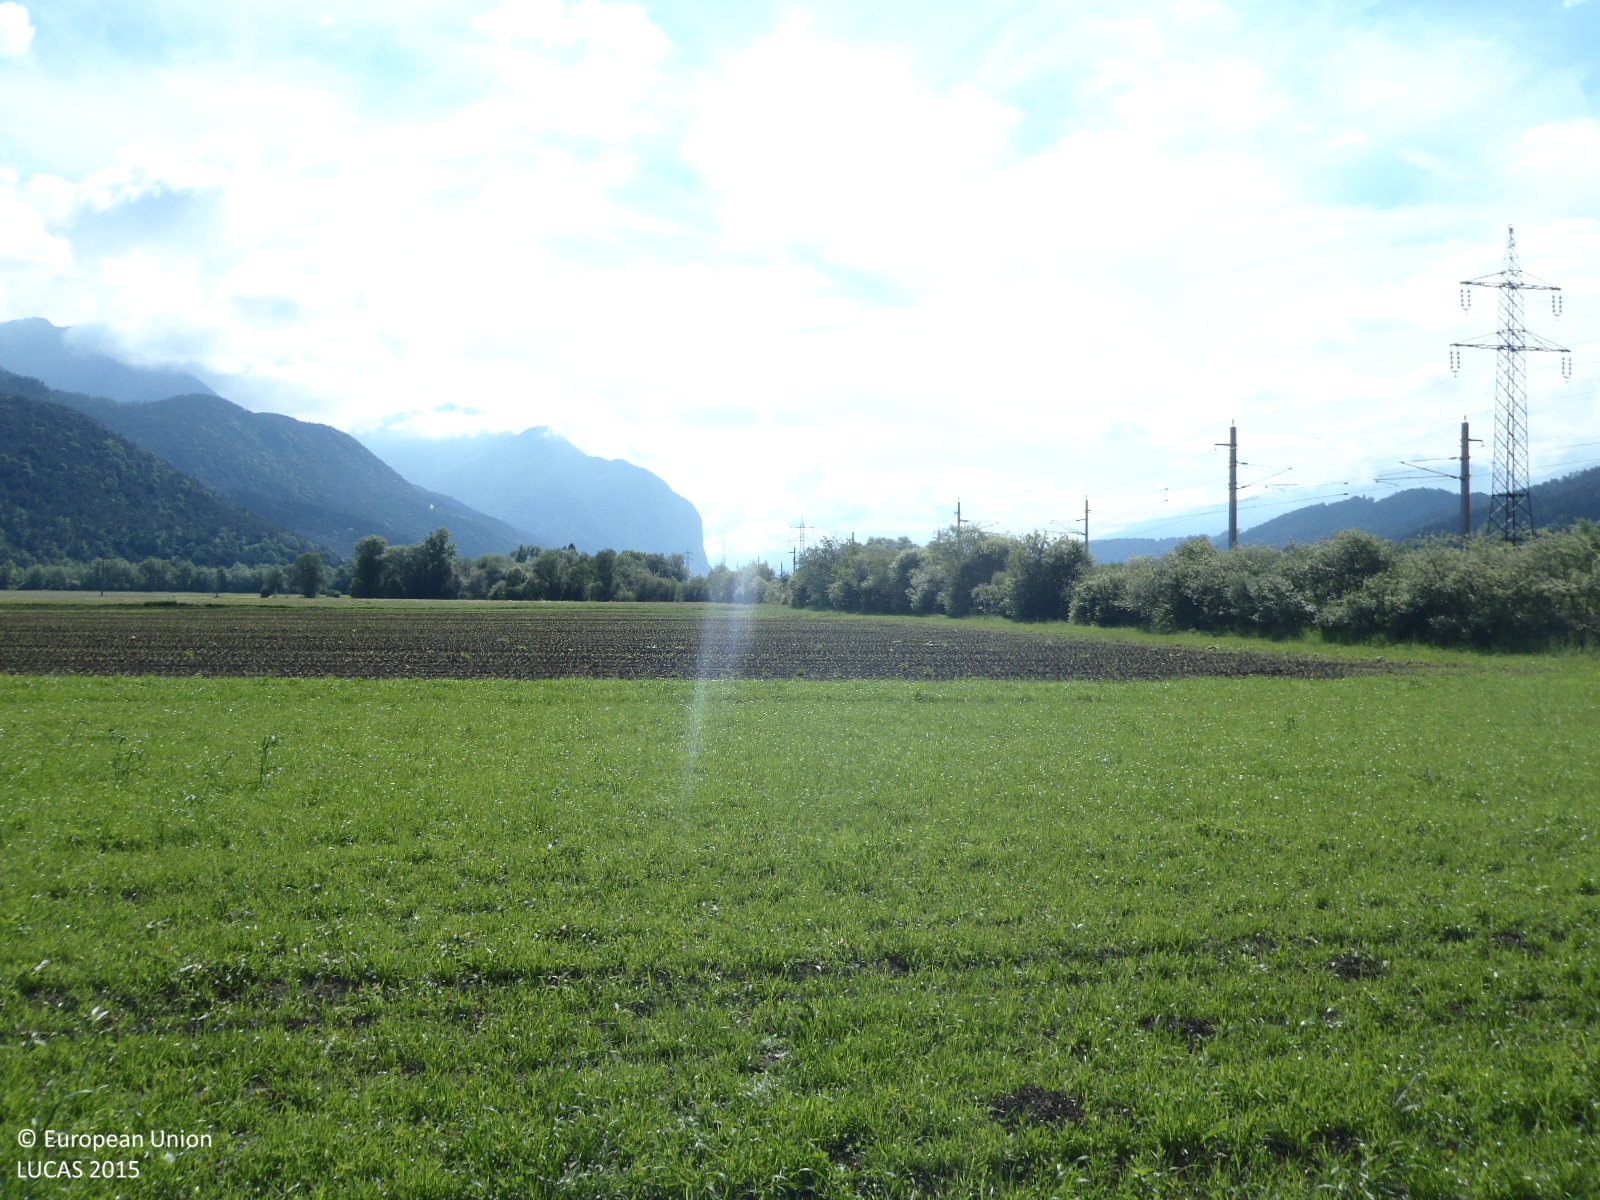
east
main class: Cropland
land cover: Temporary grasslands
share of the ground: > 75 %
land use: Agriculture (excluding fallow land and kitchen gardens)
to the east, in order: Temporary grasslands; Maize; Grass margins; Maize; Grassland without tree/shrub cover
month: May
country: AT
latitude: 47.2812
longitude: 11.1755
